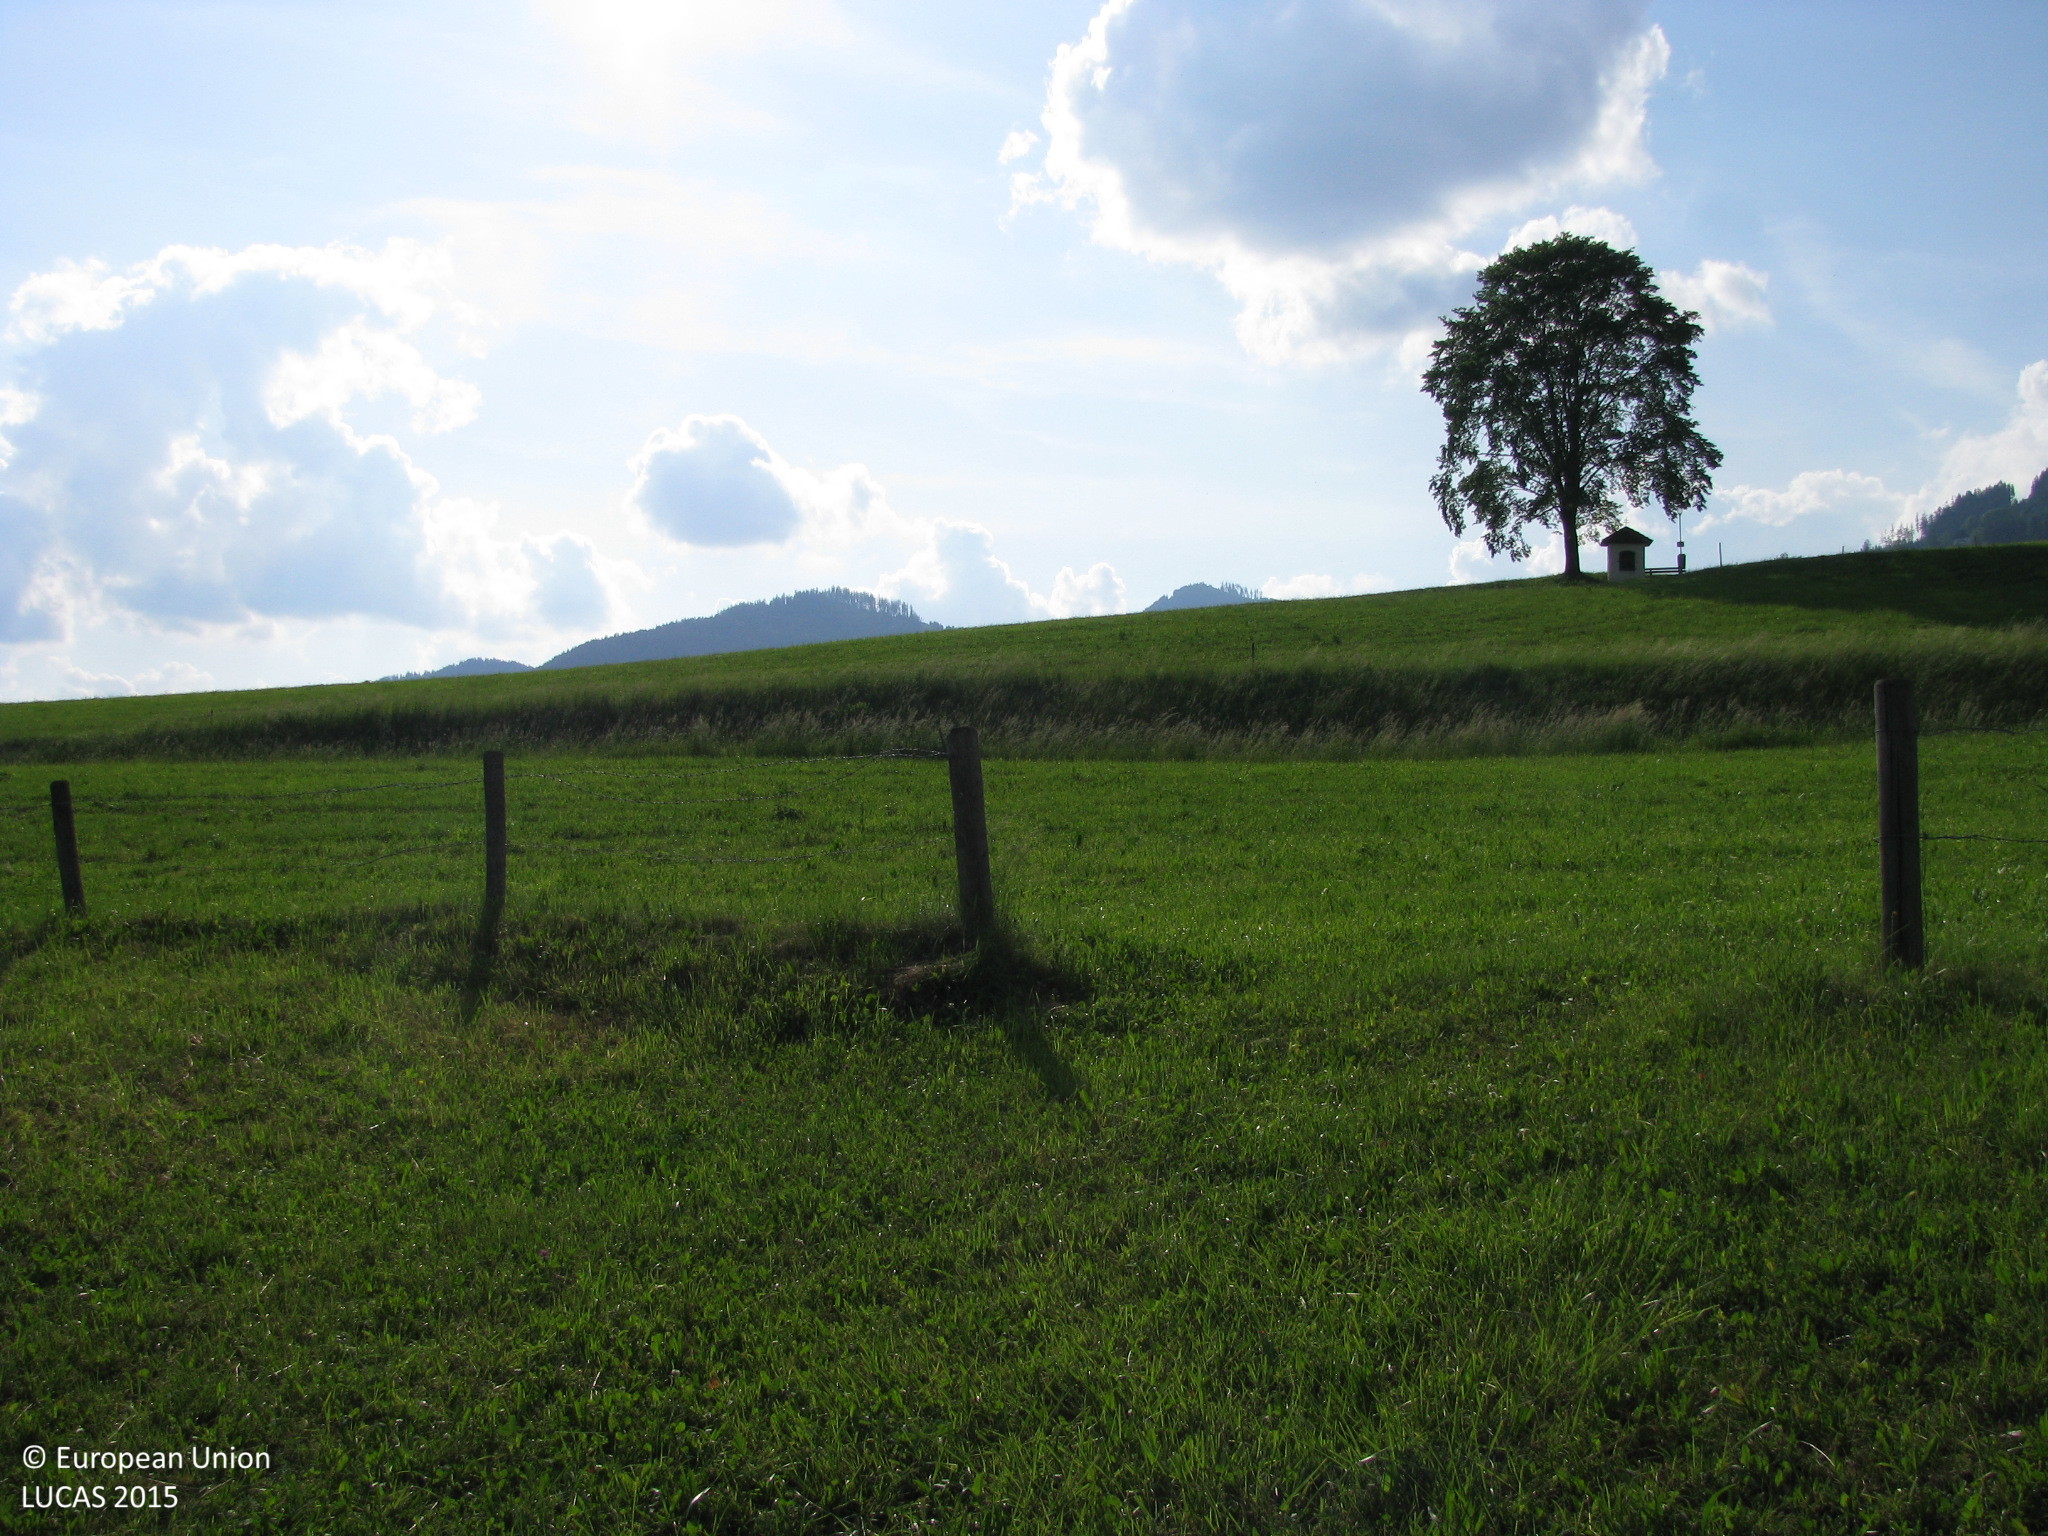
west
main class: Grassland
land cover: Grassland without tree/shrub cover
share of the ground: > 75 %
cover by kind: herbaceous plants 100 %
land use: Agriculture (excluding fallow land and kitchen gardens)
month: June
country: AT
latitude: 47.5395
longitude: 15.2481
